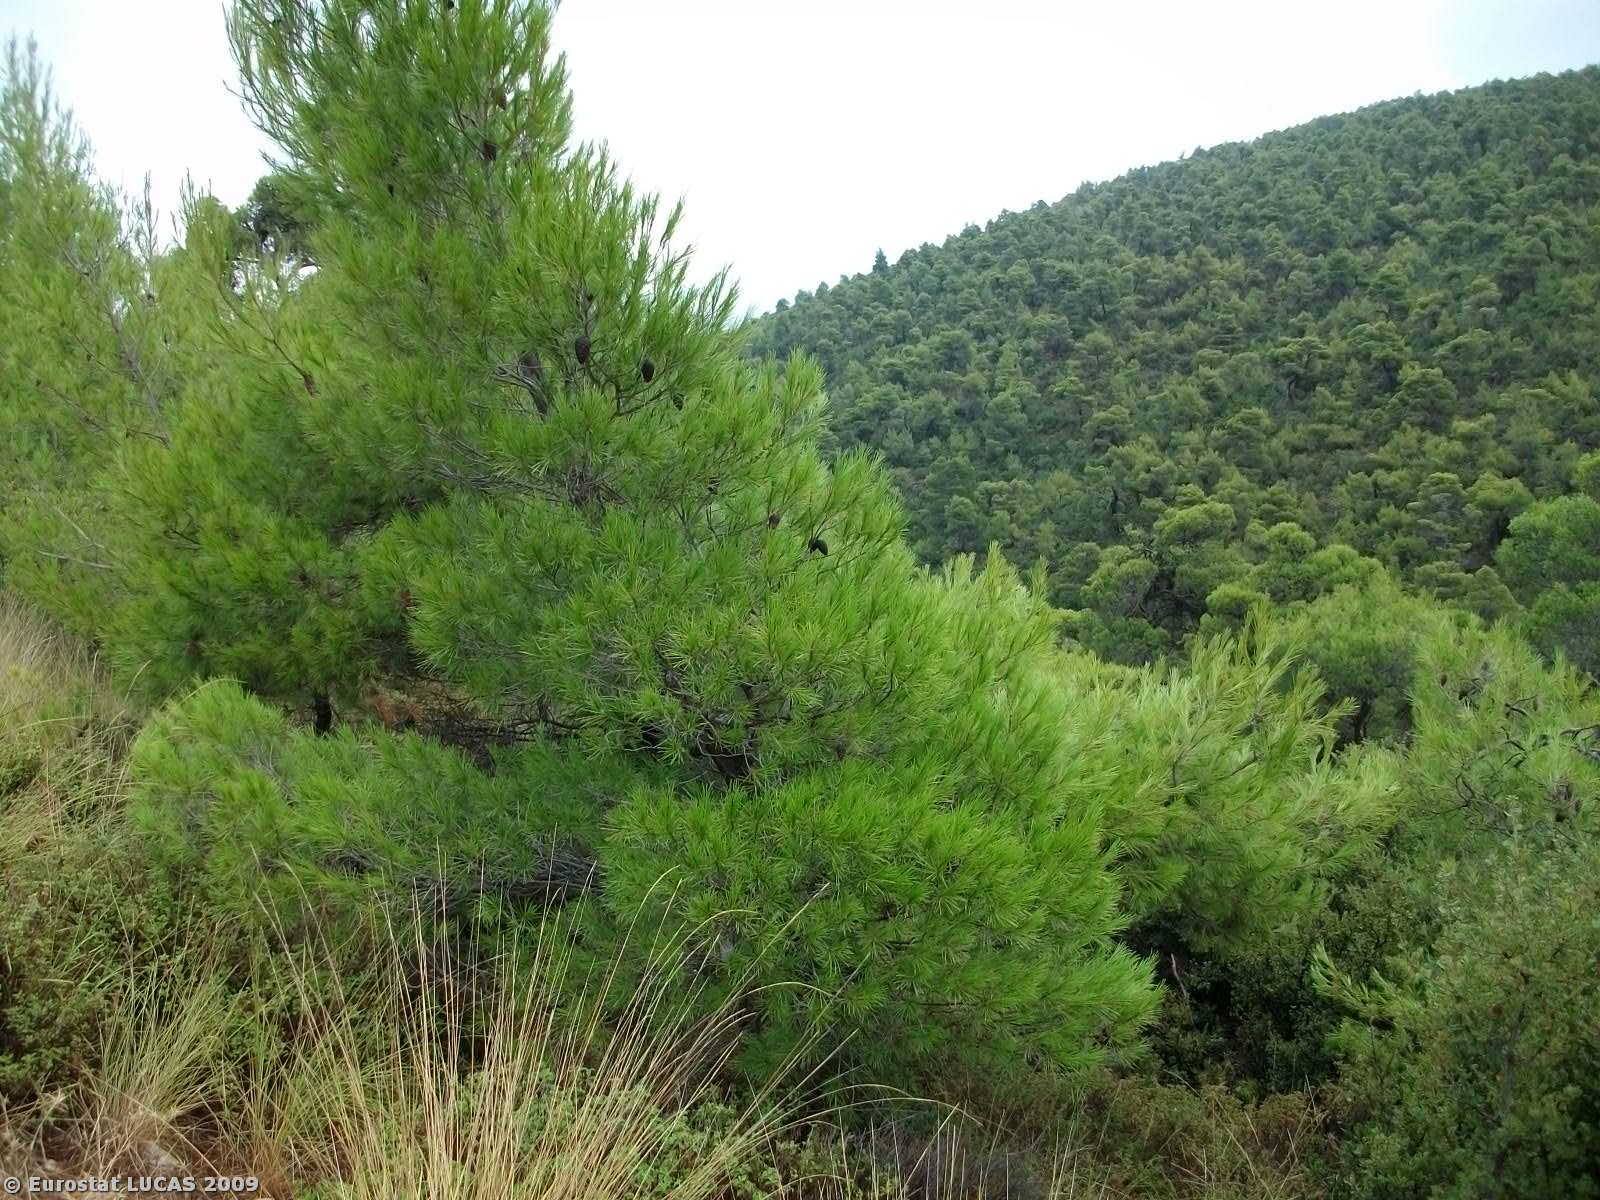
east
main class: Woodland
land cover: Coniferous woodland
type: coniferous forest of the mediterranean region
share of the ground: > 75 %
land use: Forestry
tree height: > 5 m
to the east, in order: Coniferous woodland
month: September
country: GR
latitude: 37.7902
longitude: 22.9726
